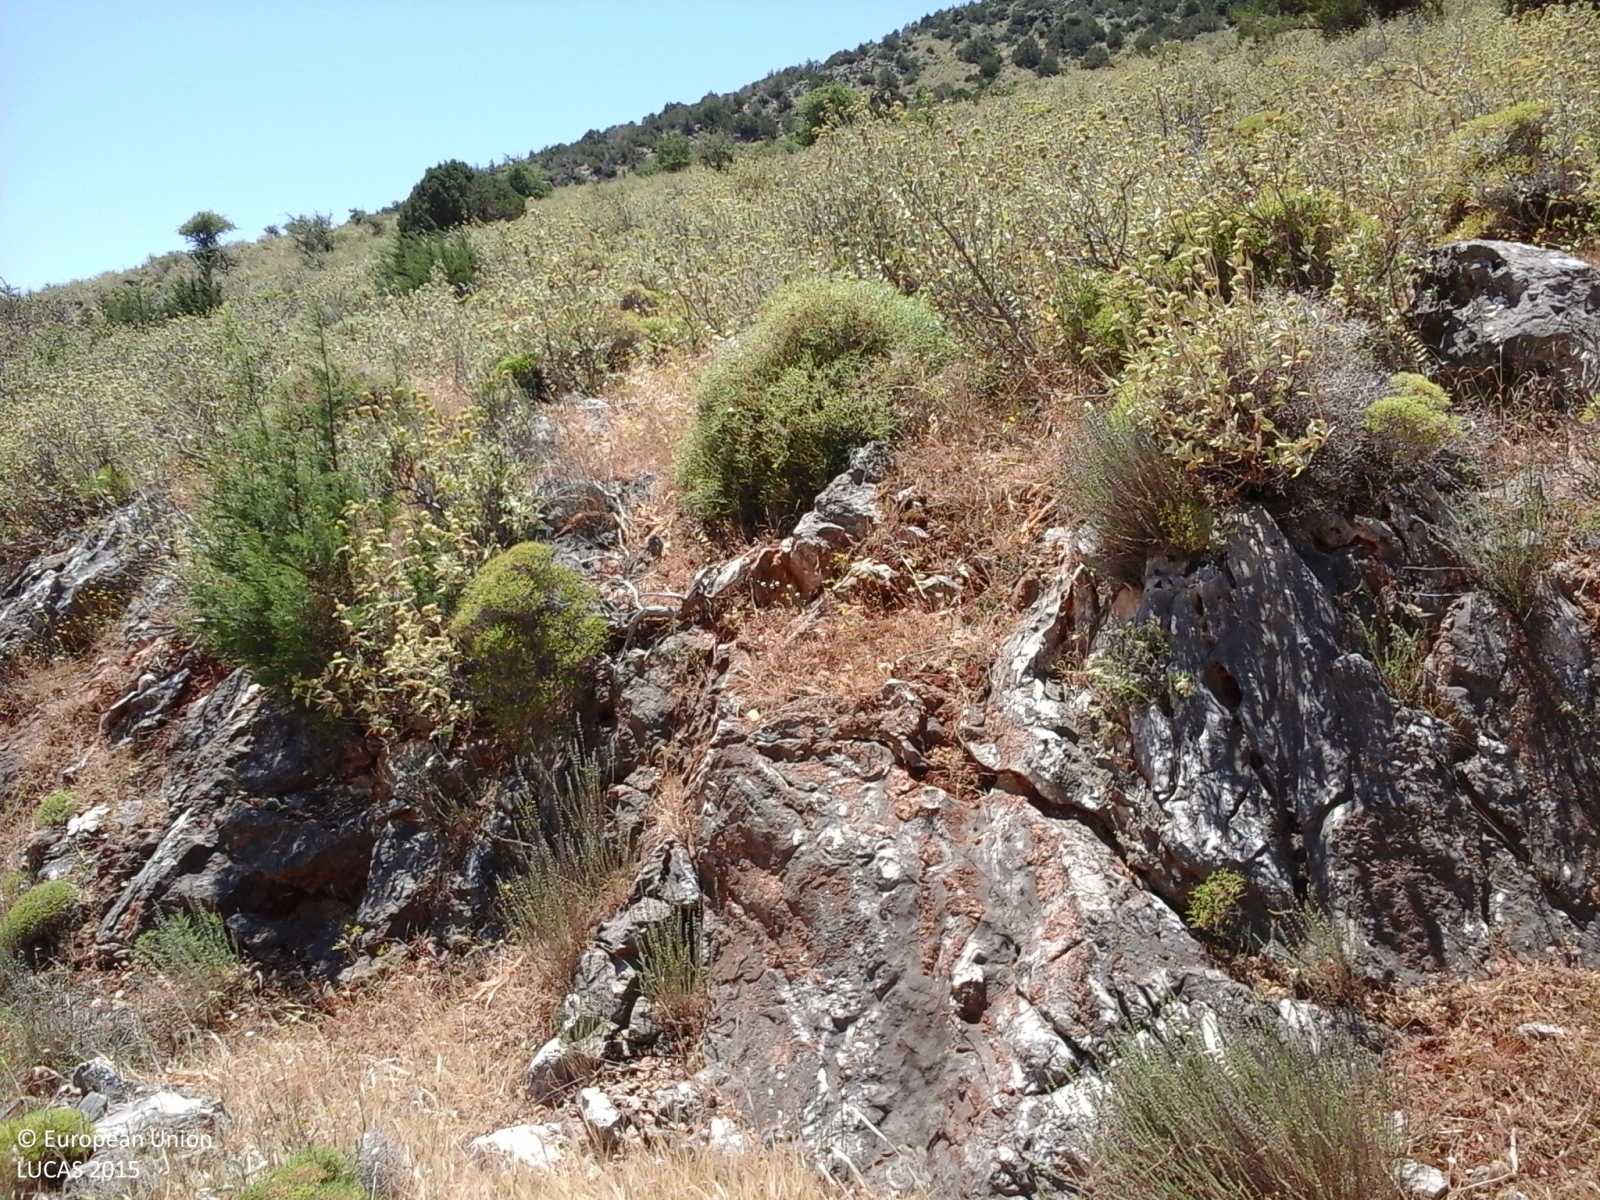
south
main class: Shrubland
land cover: Shrubland with sparse tree cover
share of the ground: 50 - 75 %
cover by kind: shrubs 55 %, herbaceous plants 10 %, unconsolidated bare surface 10 %, coniferous forest trees 5 %
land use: Semi-natural and natural areas not in use
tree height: < 5 m
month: May
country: GR
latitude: 38.3708
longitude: 22.1848
